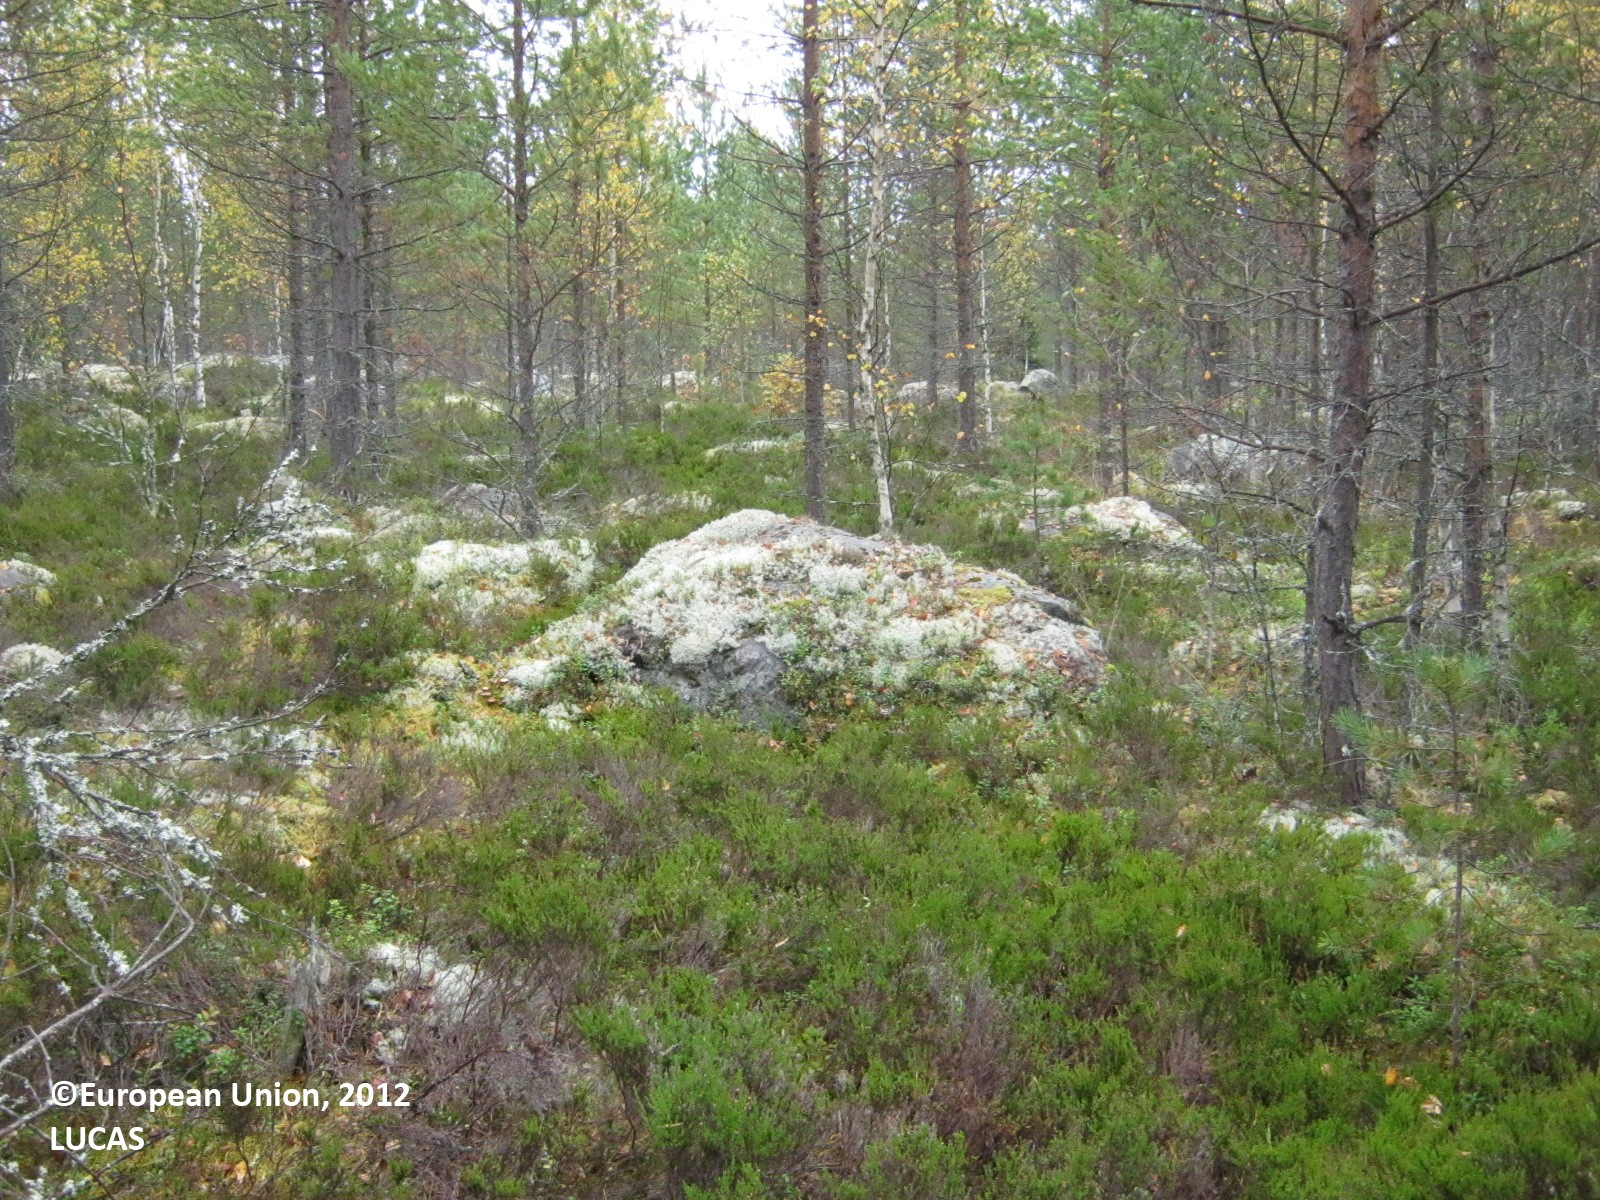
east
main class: Woodland
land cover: Pine dominated mixed woodland
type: boreal forest
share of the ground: > 75 %
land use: Forestry
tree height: > 5 m
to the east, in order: Pine dominated mixed woodland; Pine dominated coniferous woodland
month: September
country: FI
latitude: 63.4647
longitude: 26.0246
